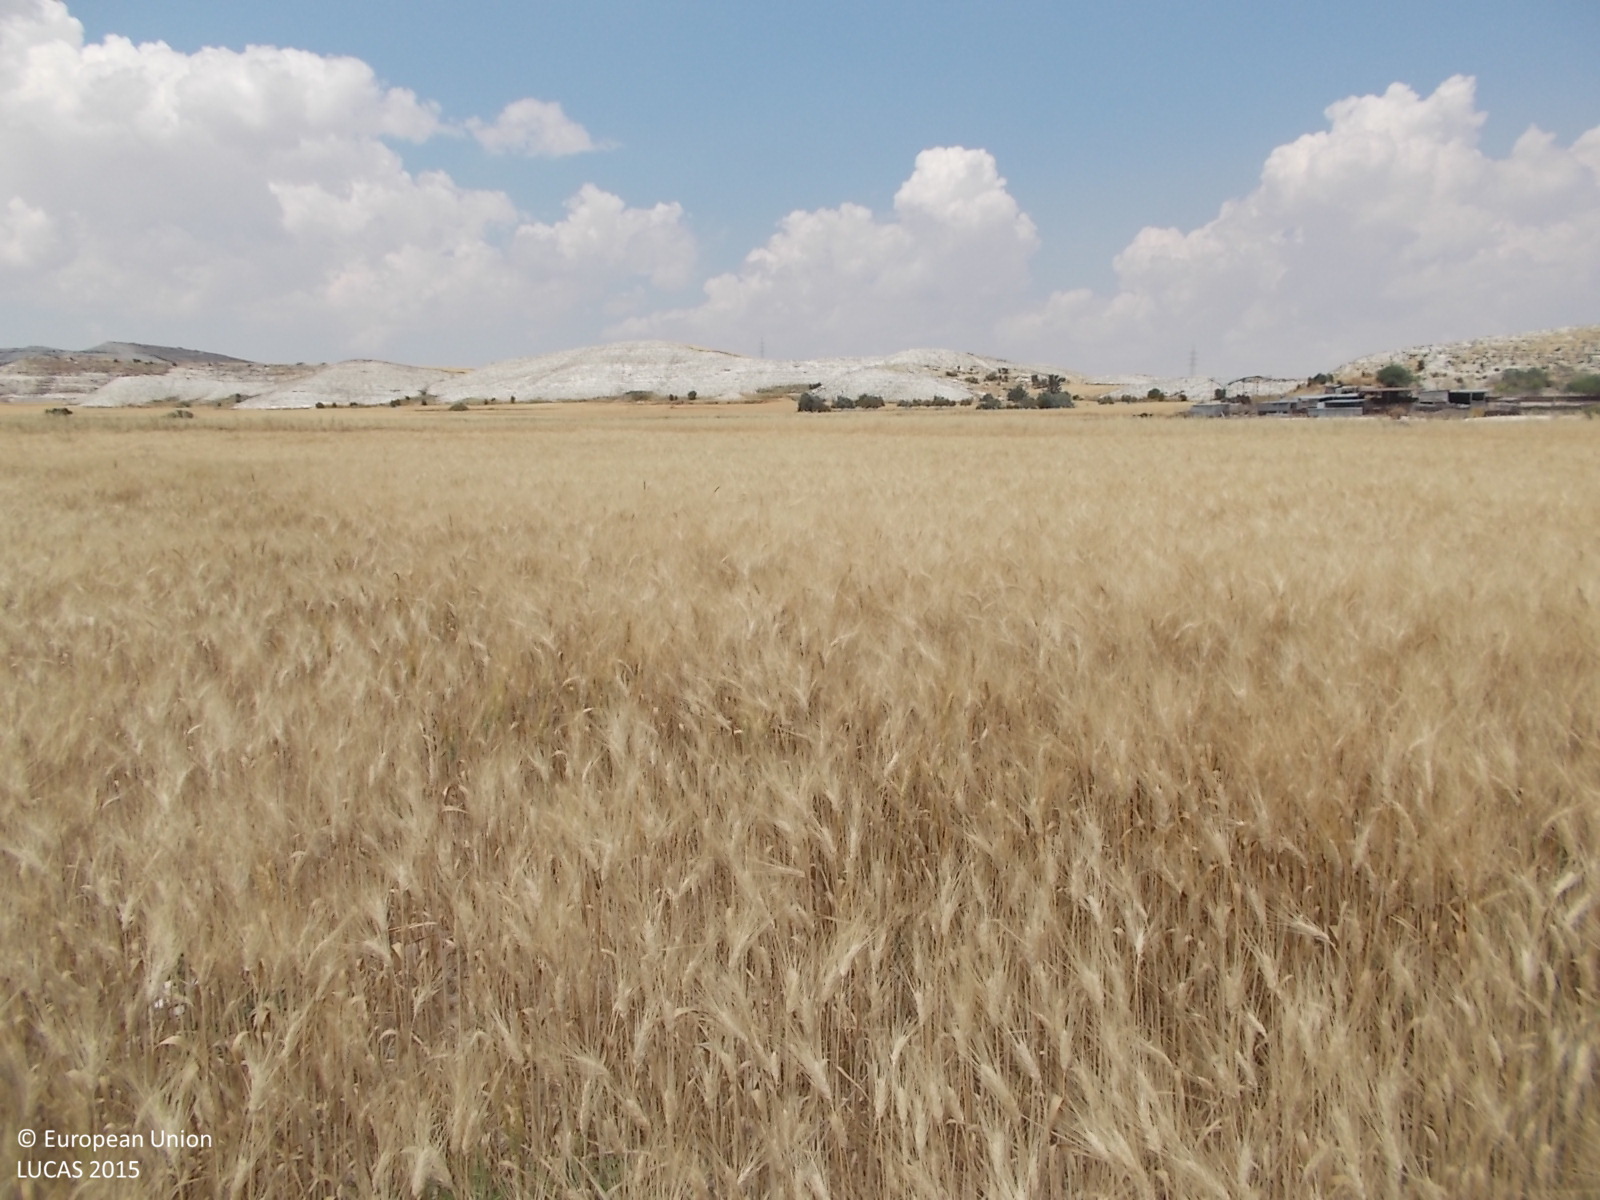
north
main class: Cropland
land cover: Durum wheat
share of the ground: > 75 %
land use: Agriculture (excluding fallow land and kitchen gardens)
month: May
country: CY
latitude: 34.9343
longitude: 33.5457
